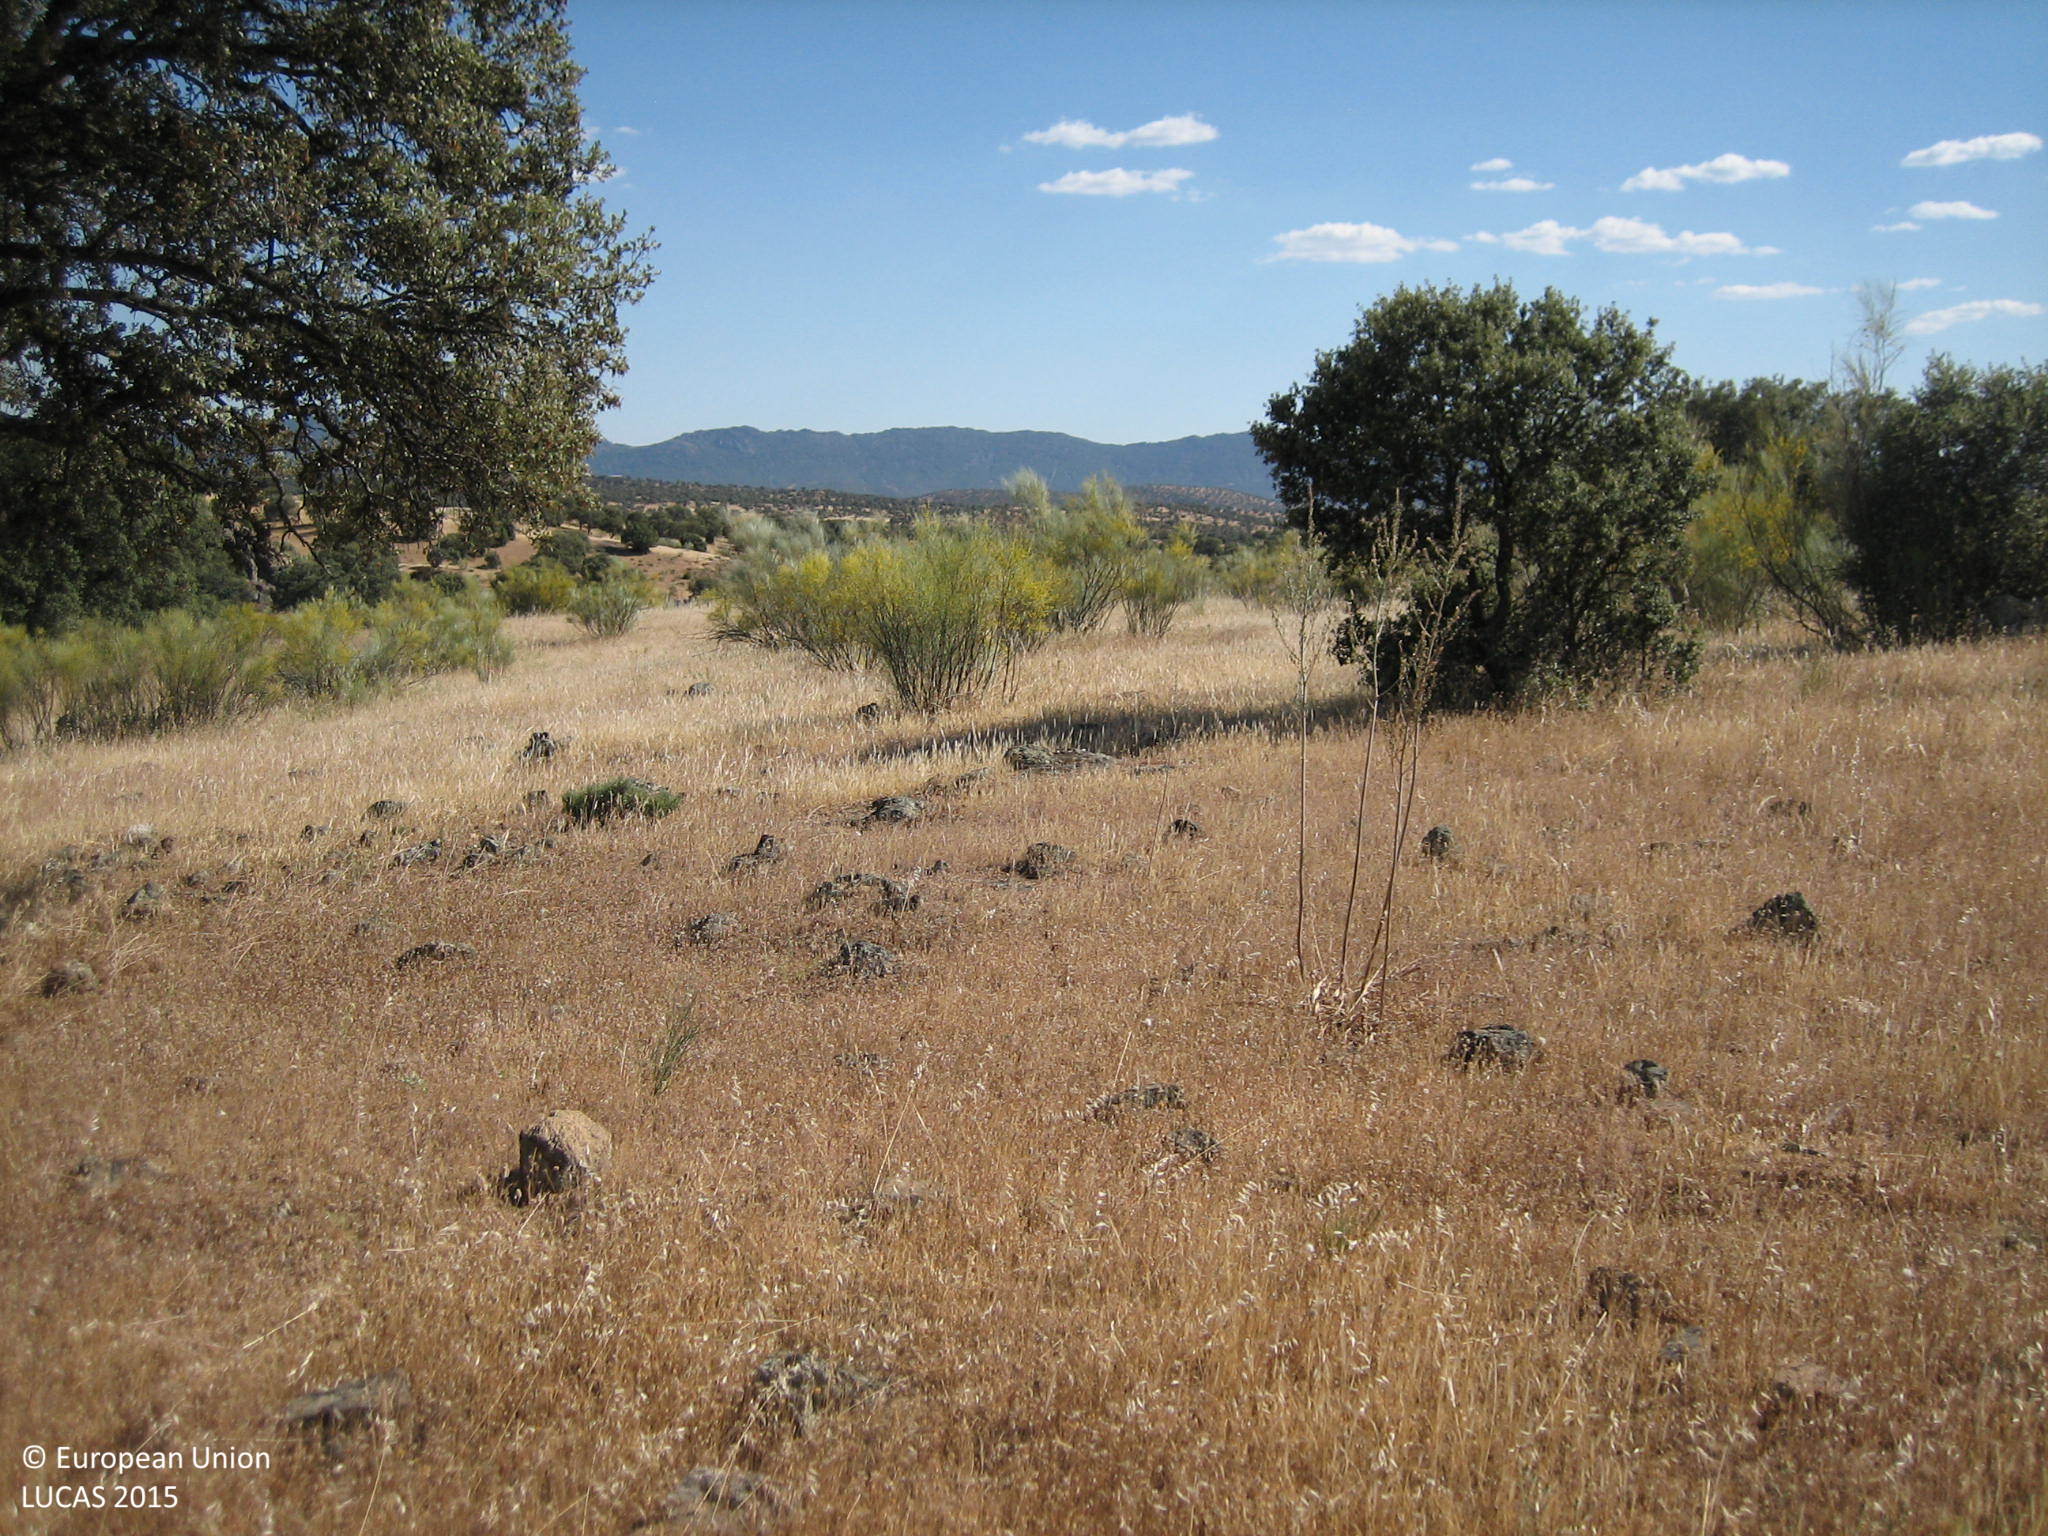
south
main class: Grassland
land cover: Grassland with sparse tree/shrub cover
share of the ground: > 75 %
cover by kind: herbaceous plants 90 %, broadleaved forest trees 5 %, shrubs 5 %
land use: Agriculture (excluding fallow land and kitchen gardens)
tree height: > 5 m
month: May
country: ES
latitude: 38.5459
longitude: -3.9780
